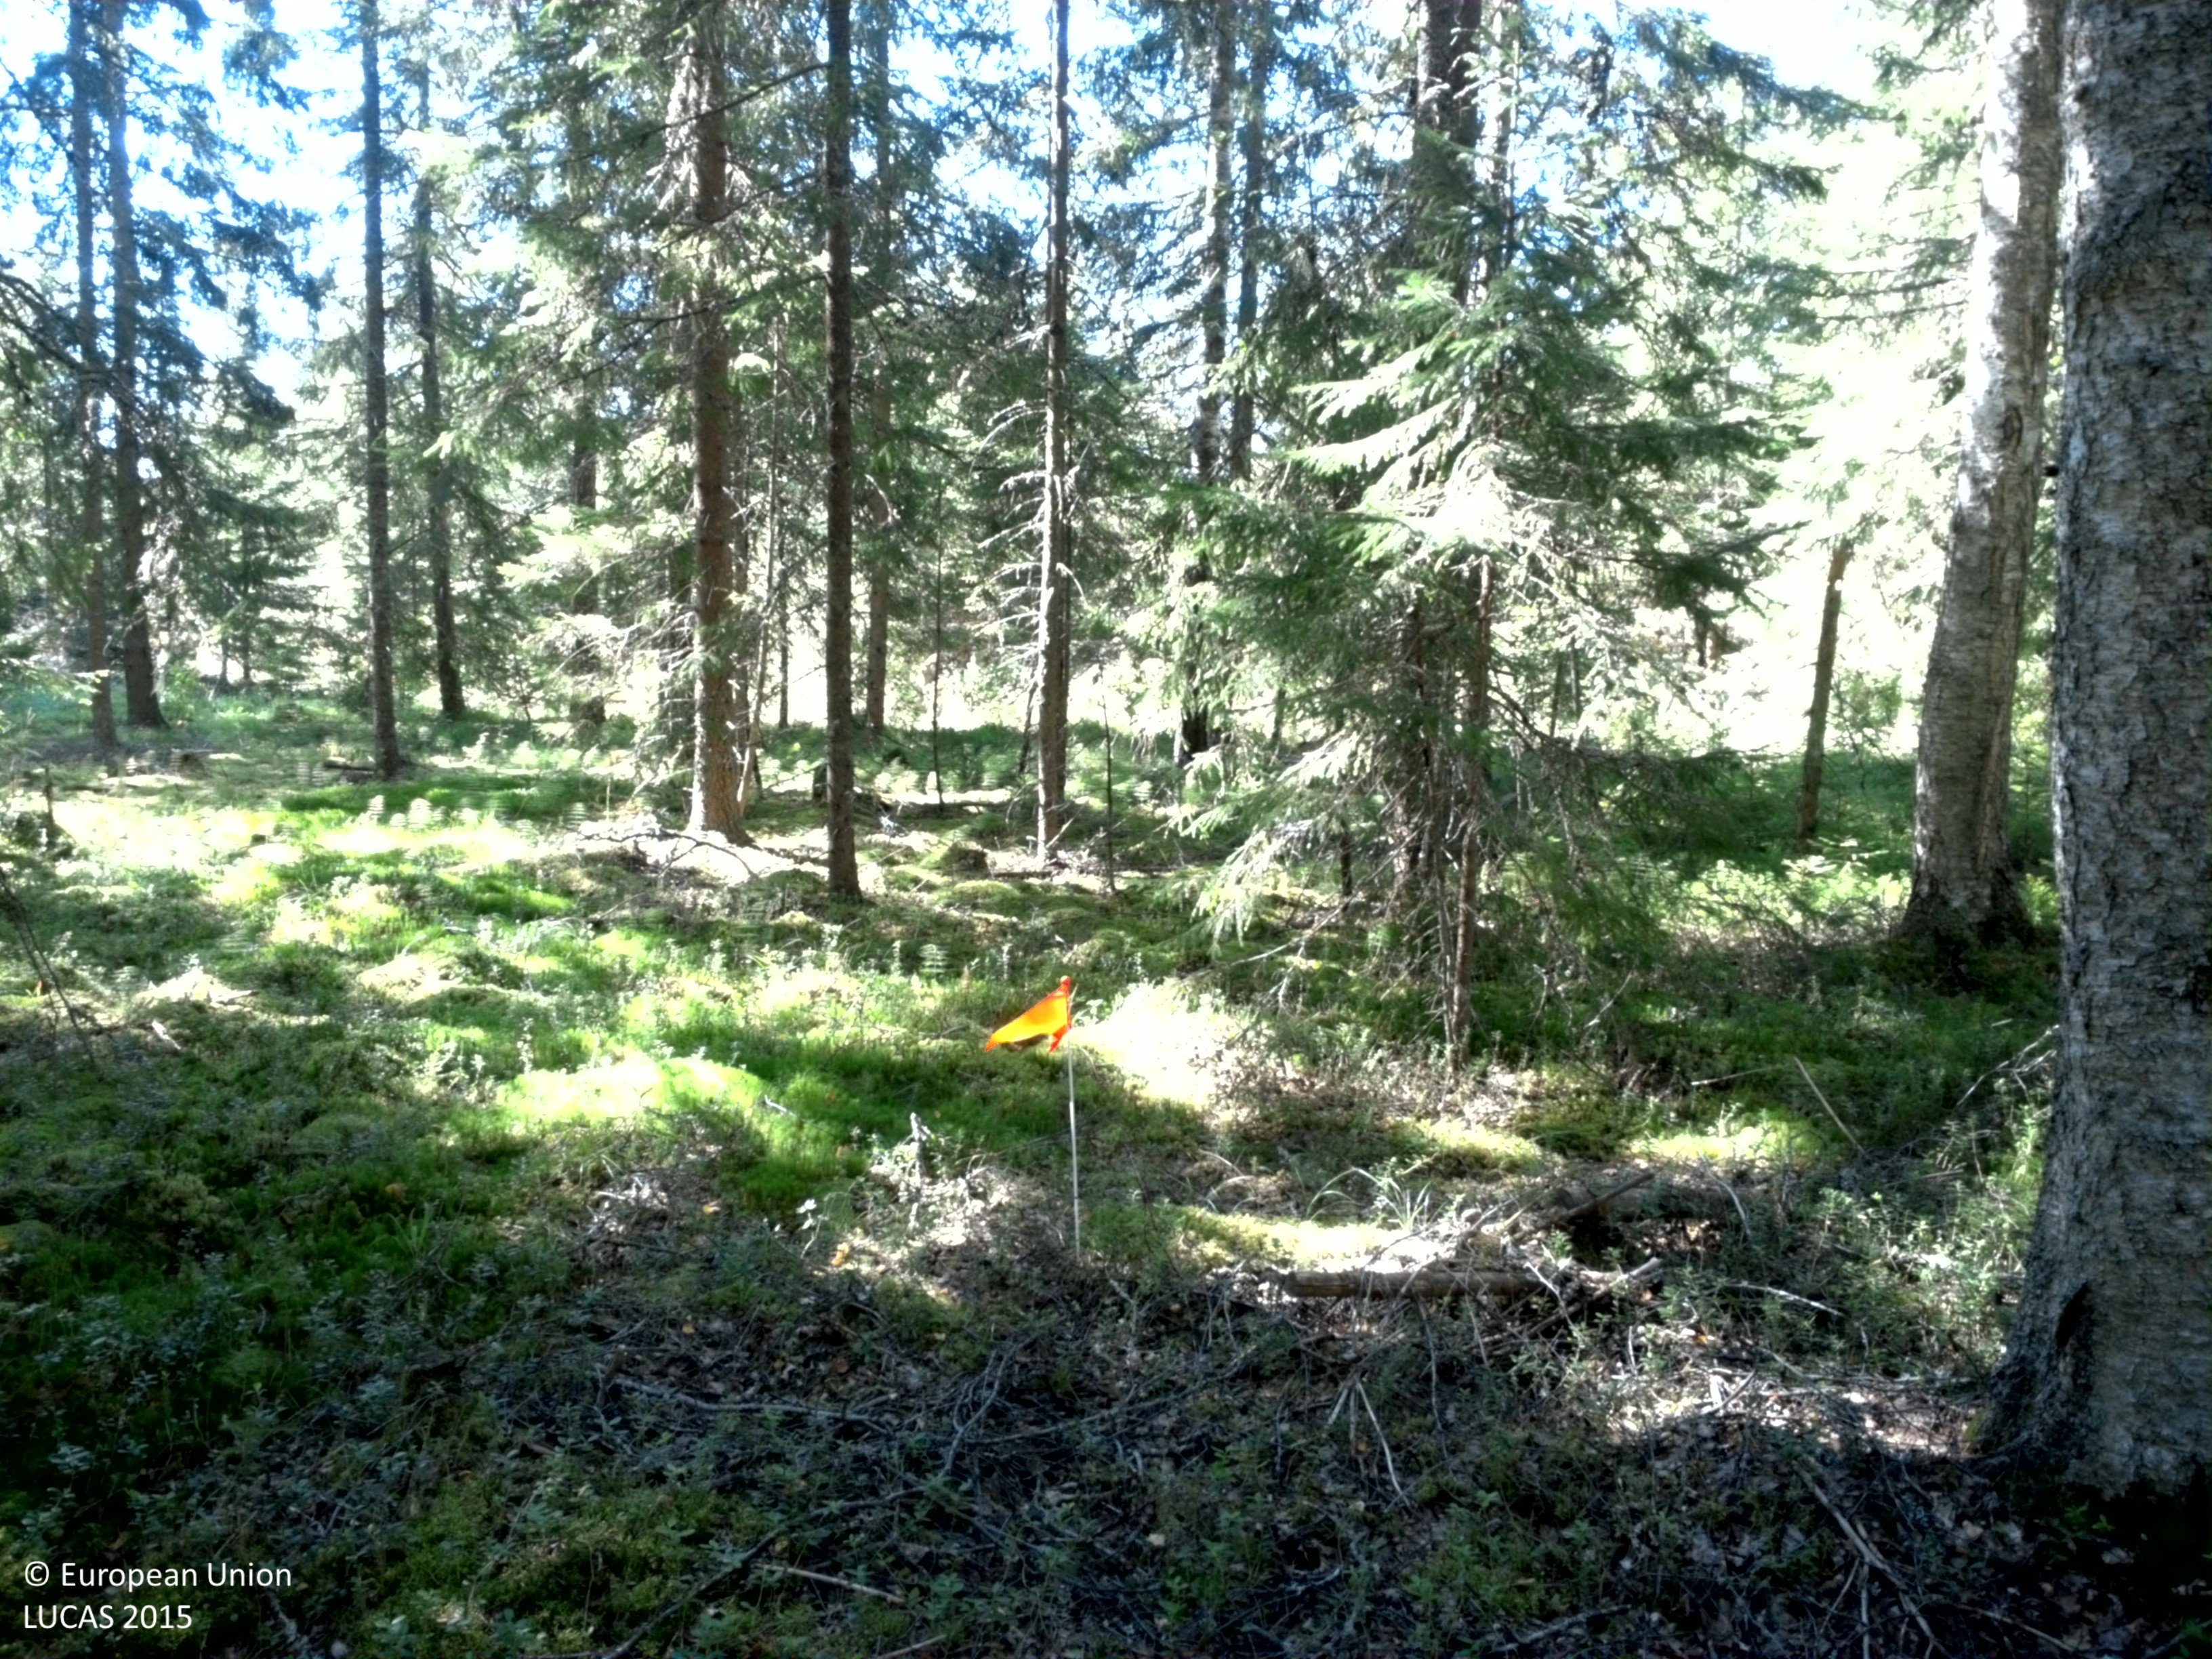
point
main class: Woodland
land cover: Spruce dominated coniferous woodland
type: boreal forest
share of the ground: > 75 %
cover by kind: coniferous forest trees 75 %, lichens and mosses 15 %, shrubs 10 %
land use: Forestry
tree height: > 5 m
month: August
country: SE
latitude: 59.6764
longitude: 15.9396
